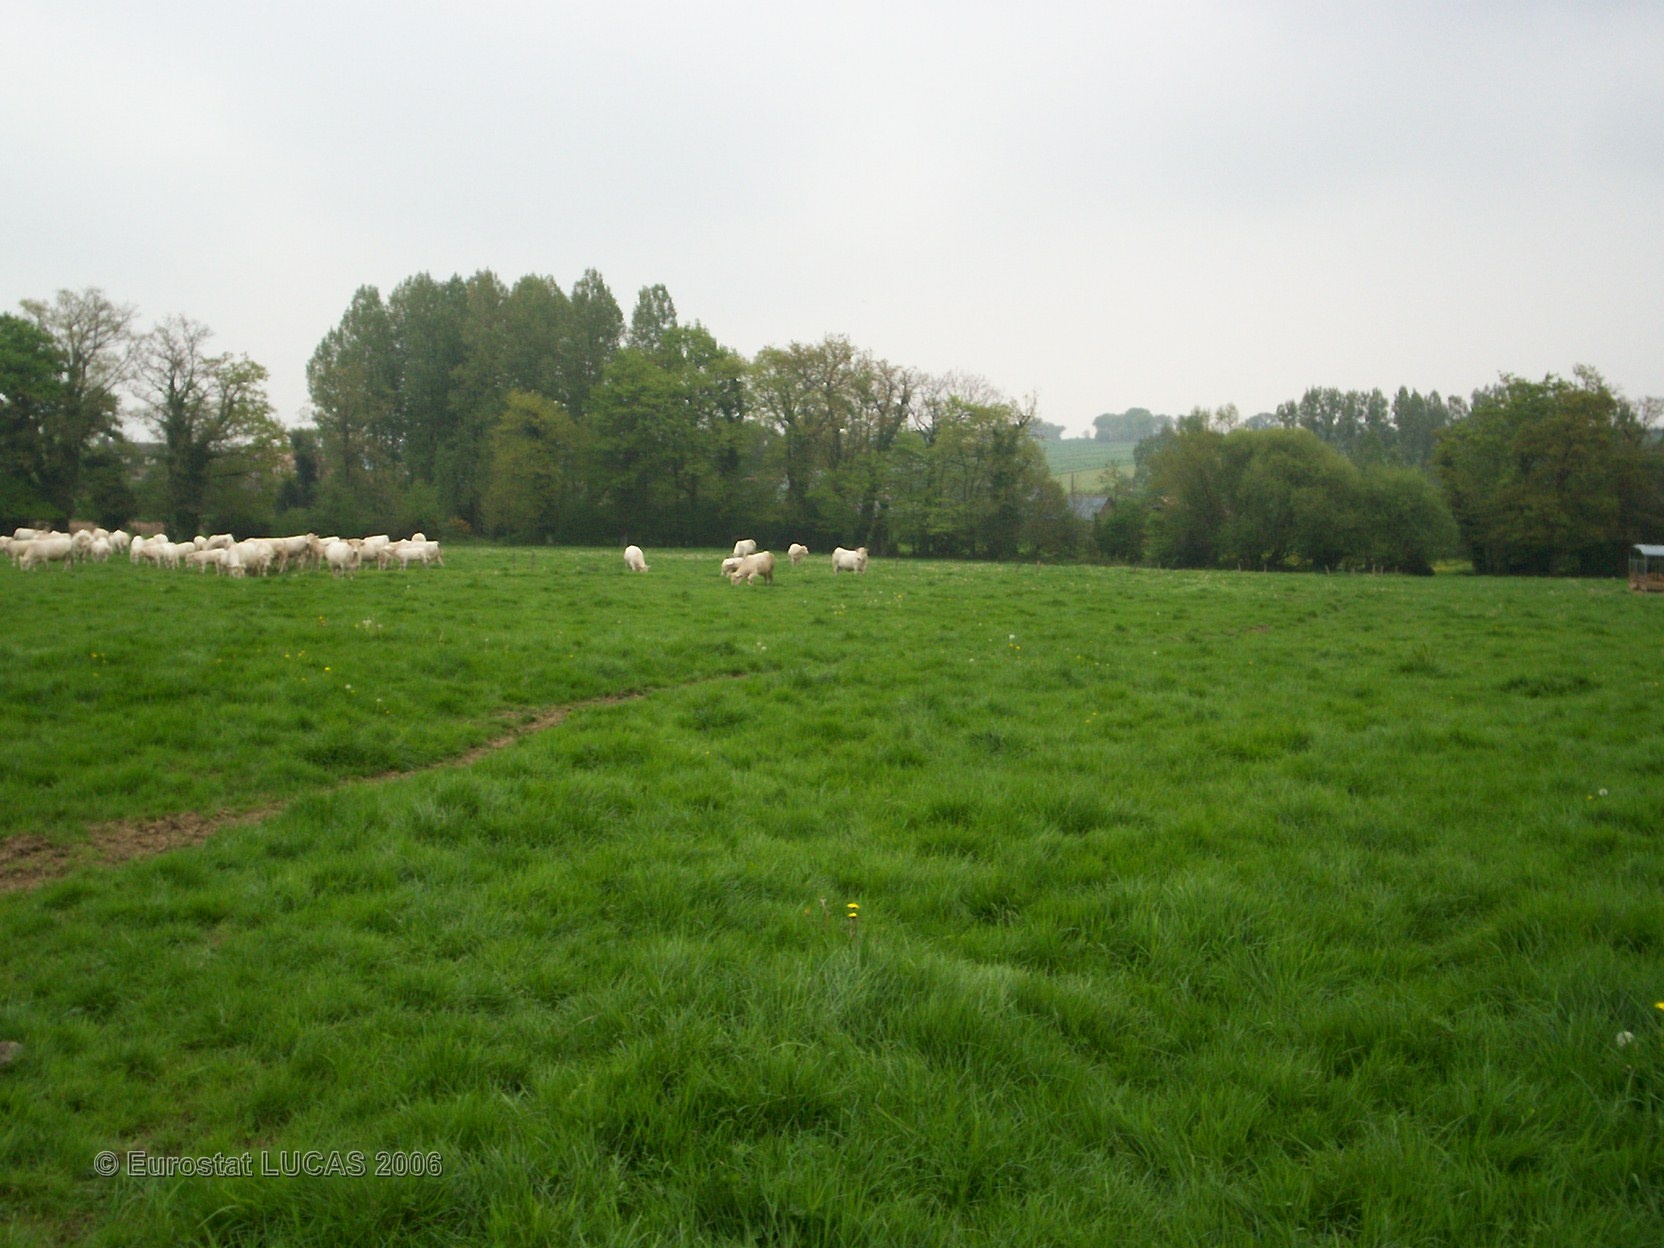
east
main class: Grassland
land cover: Grassland without tree/shrub cover
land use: Agriculture (excluding fallow land and kitchen gardens)
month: May
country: FR
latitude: 48.2004
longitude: -2.9712
